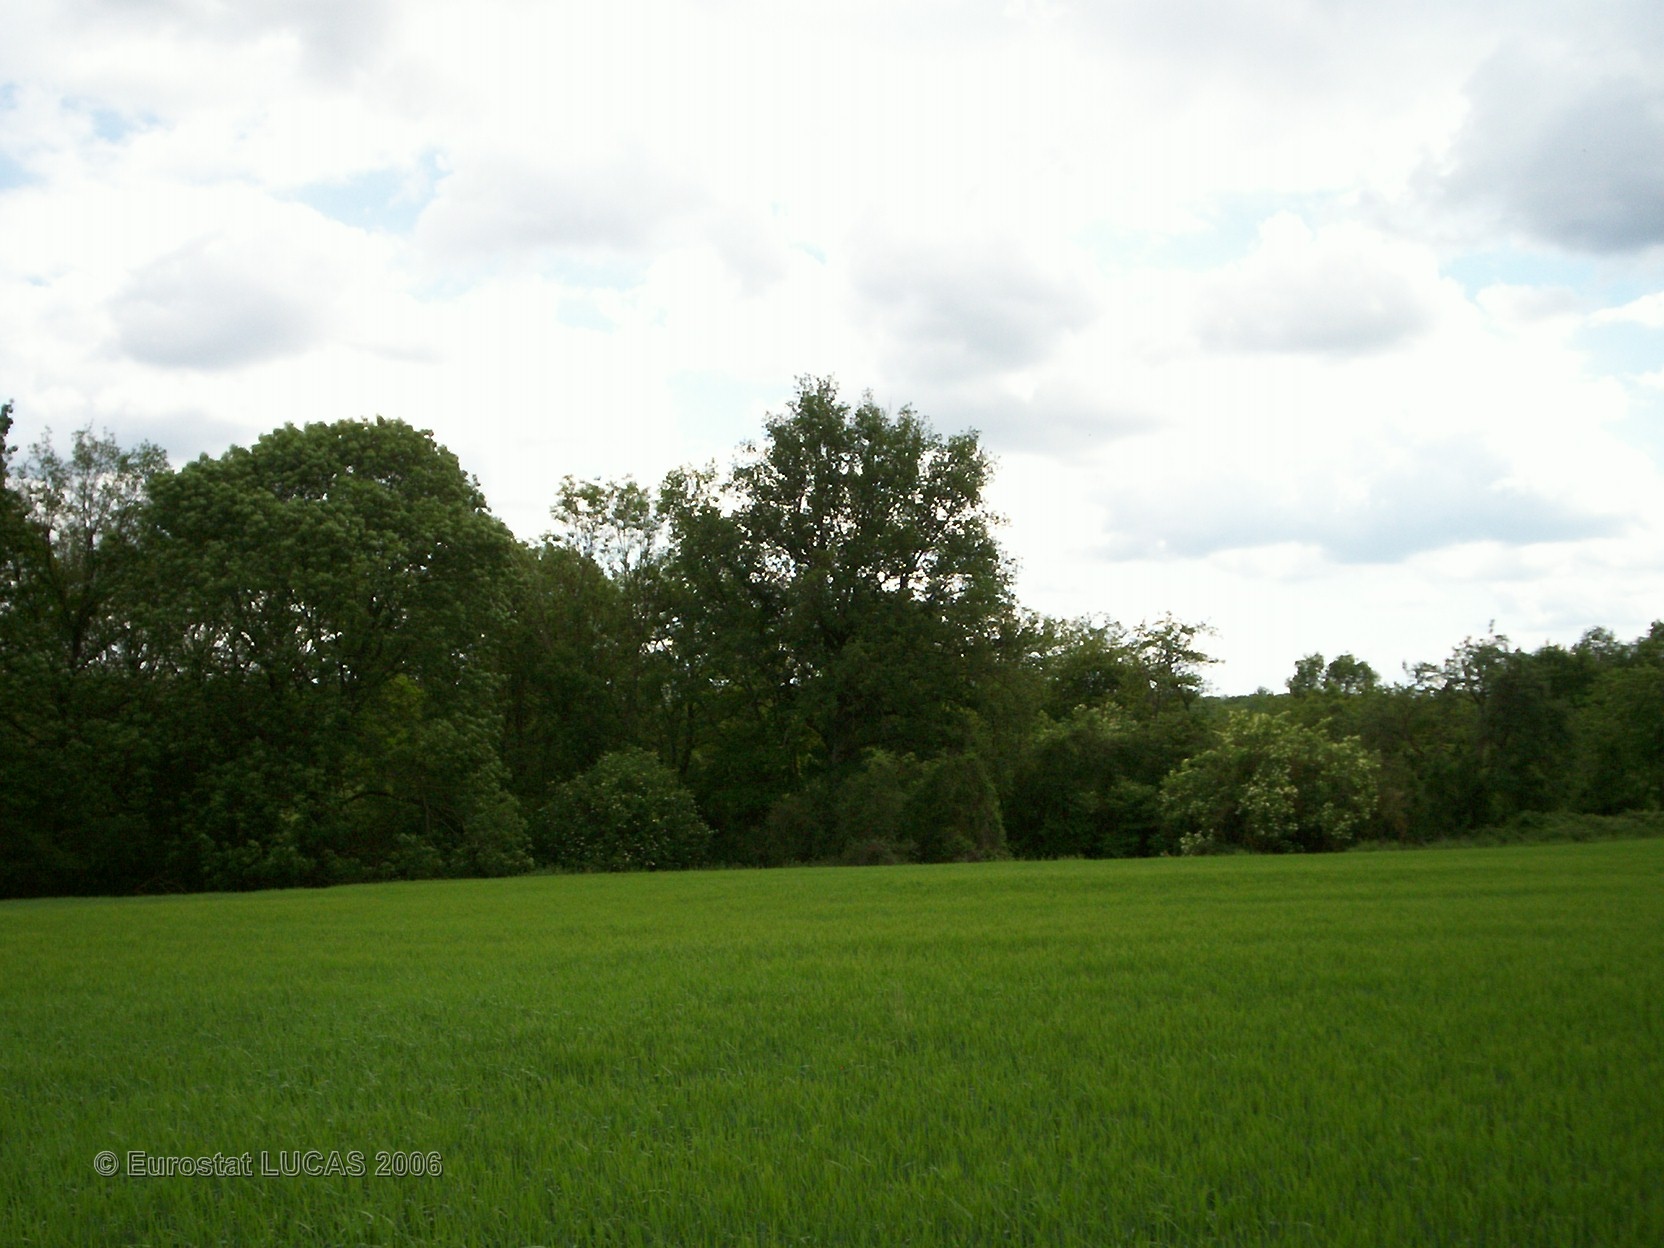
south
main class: Cropland
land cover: Barley
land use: Agriculture (excluding fallow land and kitchen gardens)
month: May
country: FR
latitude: 48.5675
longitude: 2.8220
